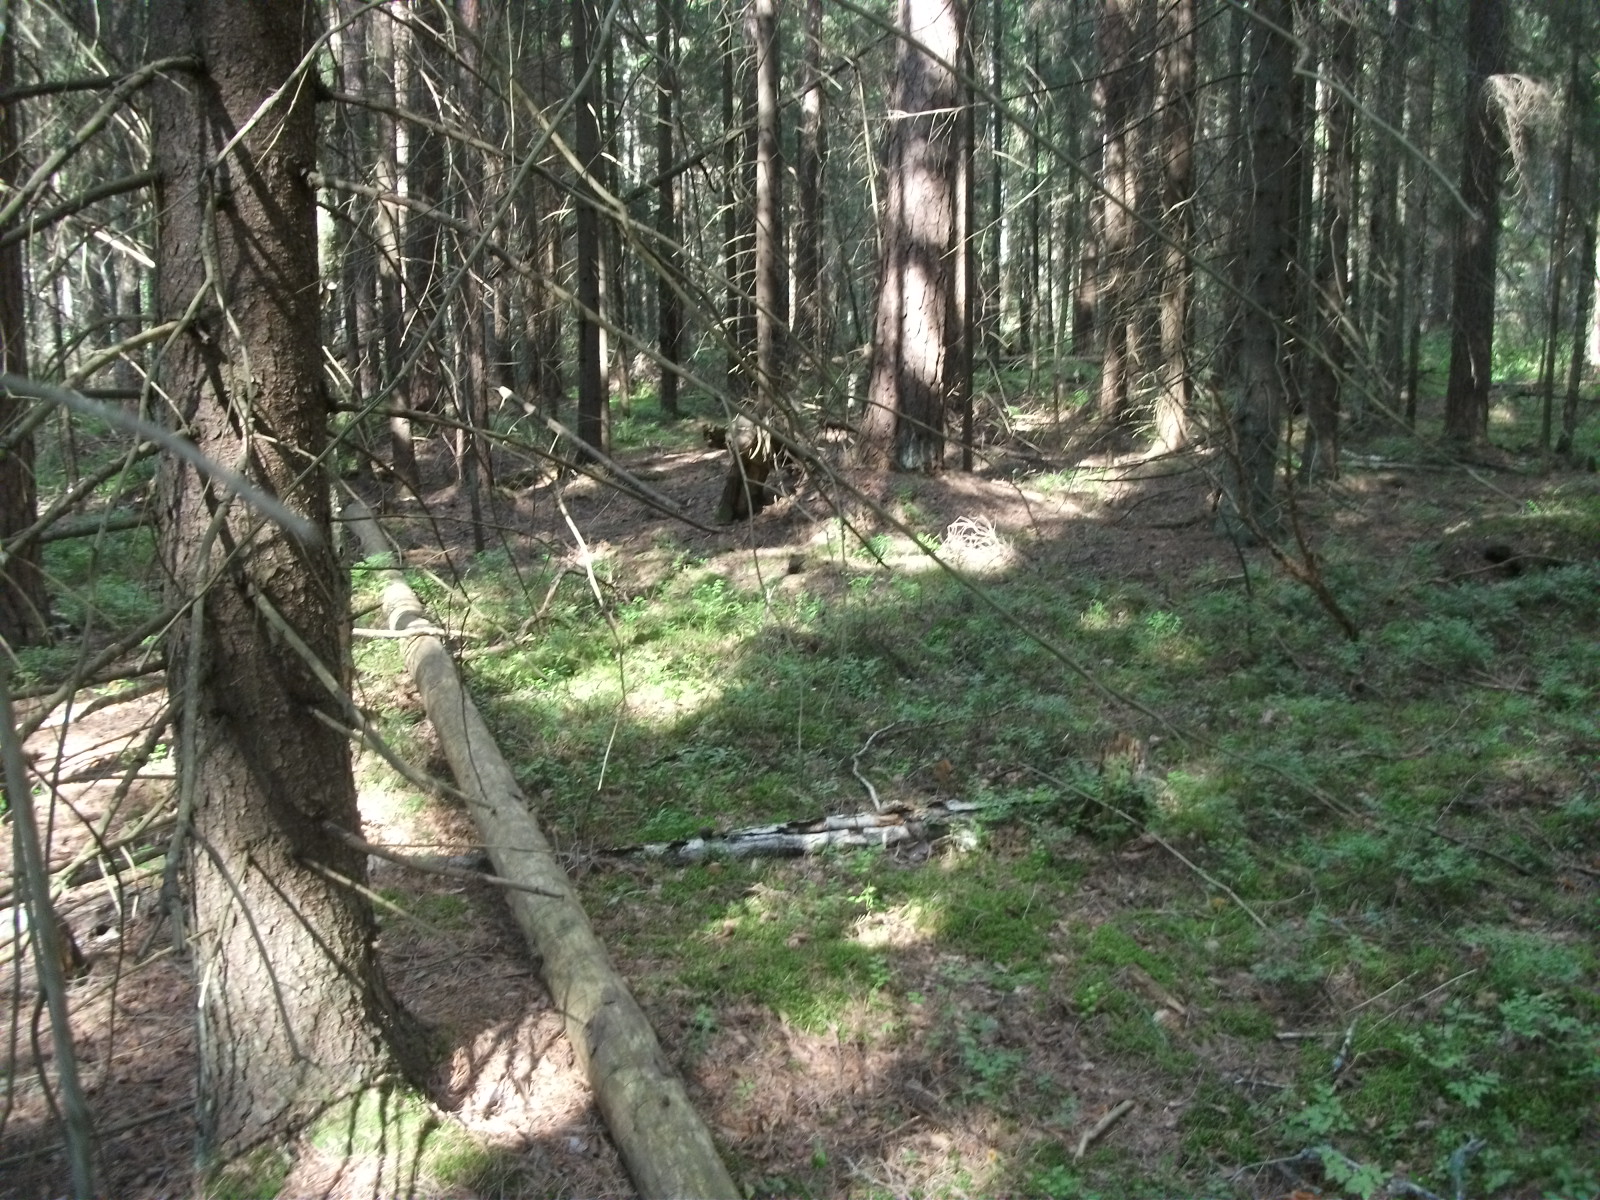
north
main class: Woodland
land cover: Other coniferous woodland
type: hemiboreal forest and nemoral coniferous forest and mixed broadleaved-coniferous forest
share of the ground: > 75 %
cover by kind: coniferous forest trees 80 %, shrubs 5 %, herbaceous plants 5 %, lichens and mosses 5 %, unconsolidated bare surface 5 %
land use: Forestry
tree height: > 5 m
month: August
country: LV
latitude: 56.8010
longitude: 26.5055
